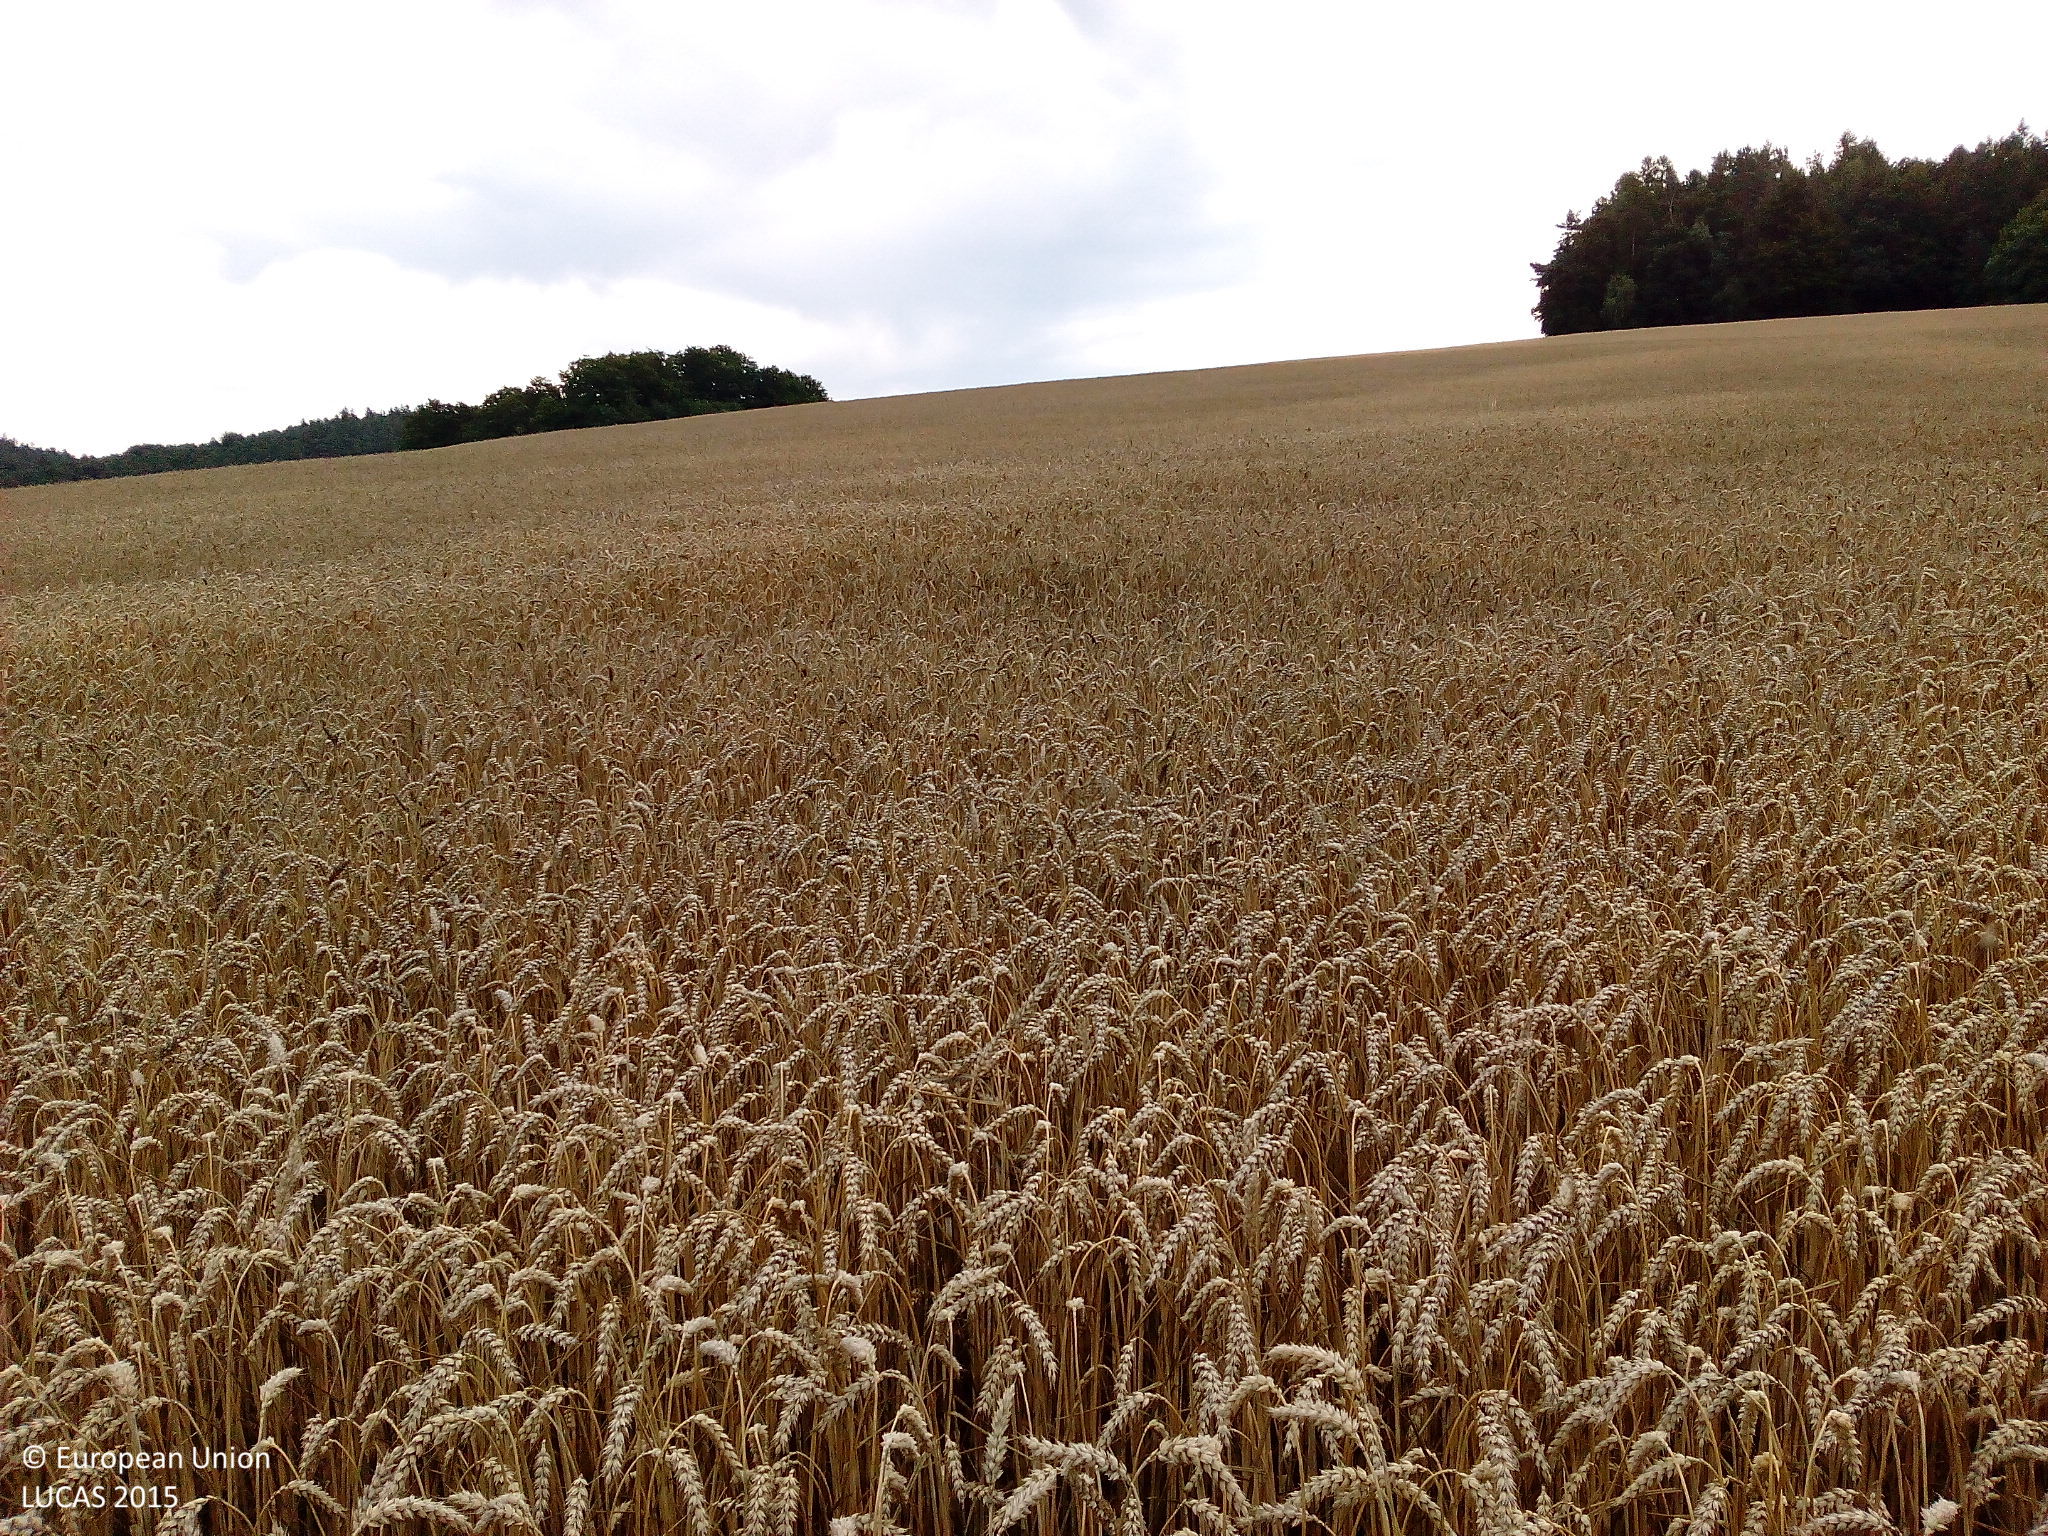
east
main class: Cropland
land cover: Common wheat
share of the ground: > 75 %
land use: Agriculture (excluding fallow land and kitchen gardens)
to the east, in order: Common wheat; Barley
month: August
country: DE
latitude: 50.7409
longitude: 9.5892
